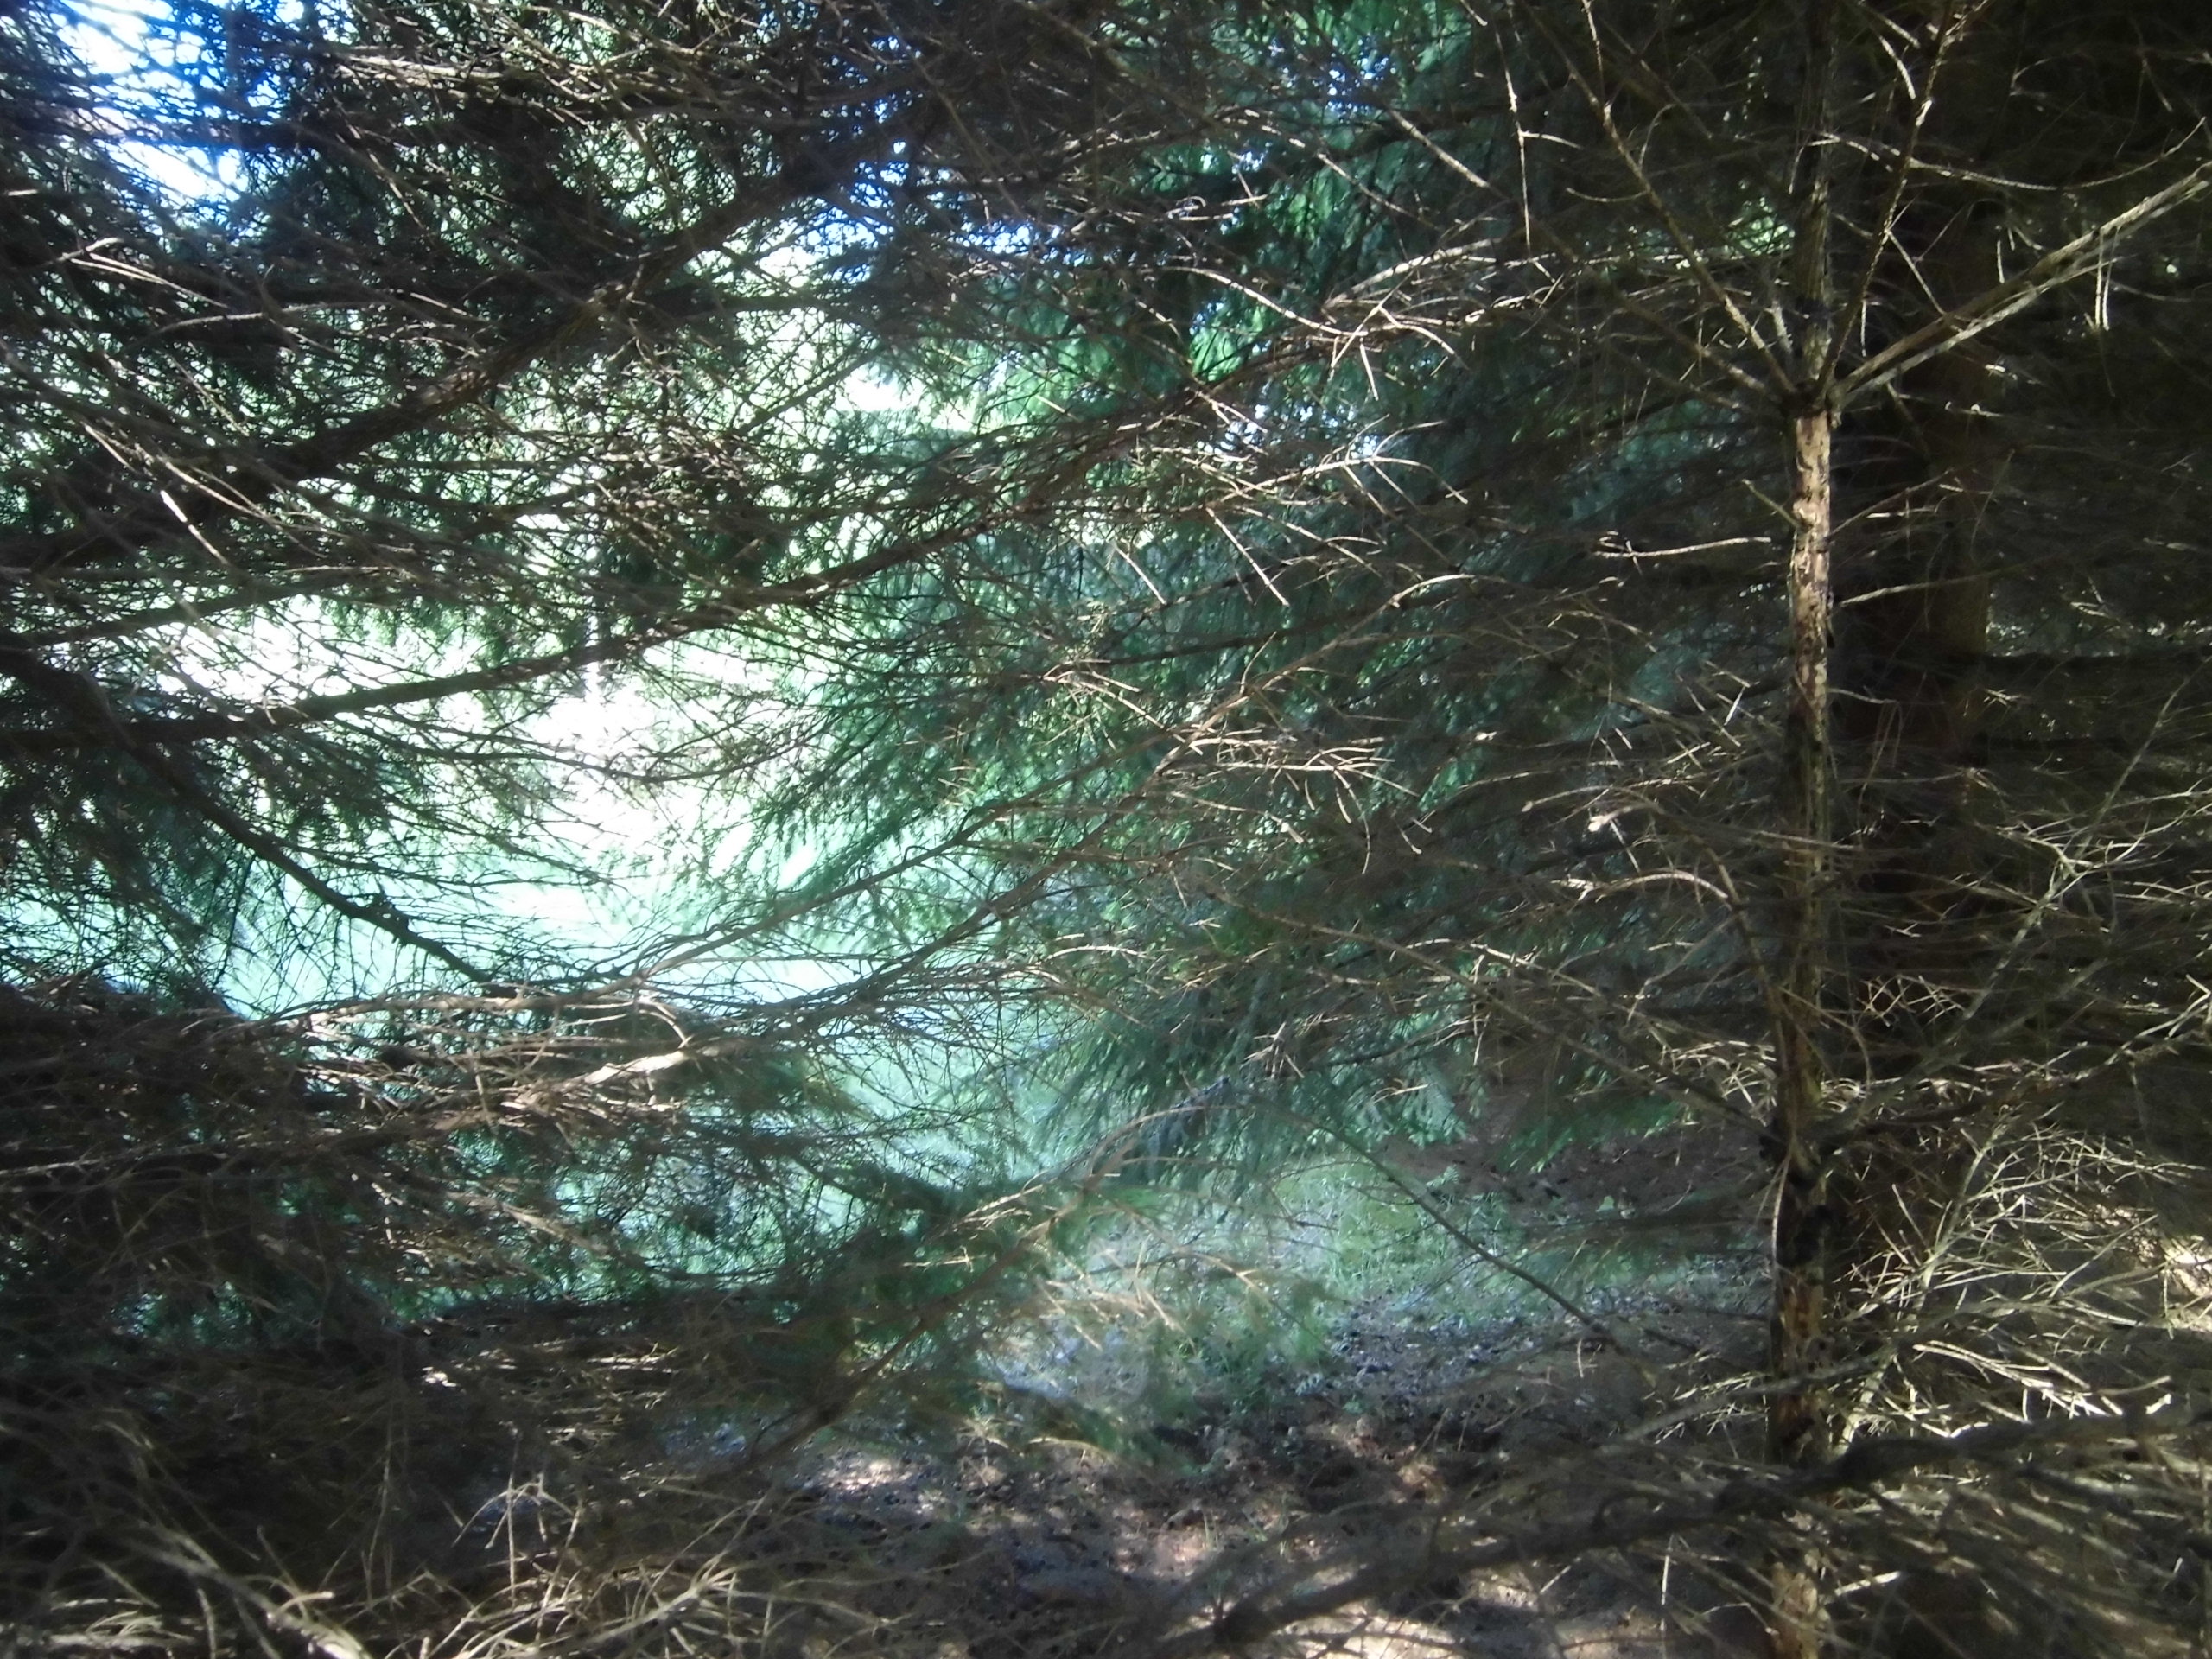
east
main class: Woodland
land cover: Spruce dominated coniferous woodland
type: boreal forest
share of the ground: > 75 %
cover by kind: coniferous forest trees 80 %, unconsolidated bare surface 15 %, herbaceous plants 5 %
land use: Forestry
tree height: > 5 m
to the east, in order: Spruce dominated coniferous woodland; Grassland with sparse tree/shrub cover; Spruce dominated coniferous woodland; Tracks; Ditches and canals; Spruce dominated coniferous woodland; Dry stone walls; Spruce dominated coniferous woodland; Rivers and streams; Spruce dominated coniferous woodland
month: July
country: SE
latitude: 57.1608
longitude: 15.2716
